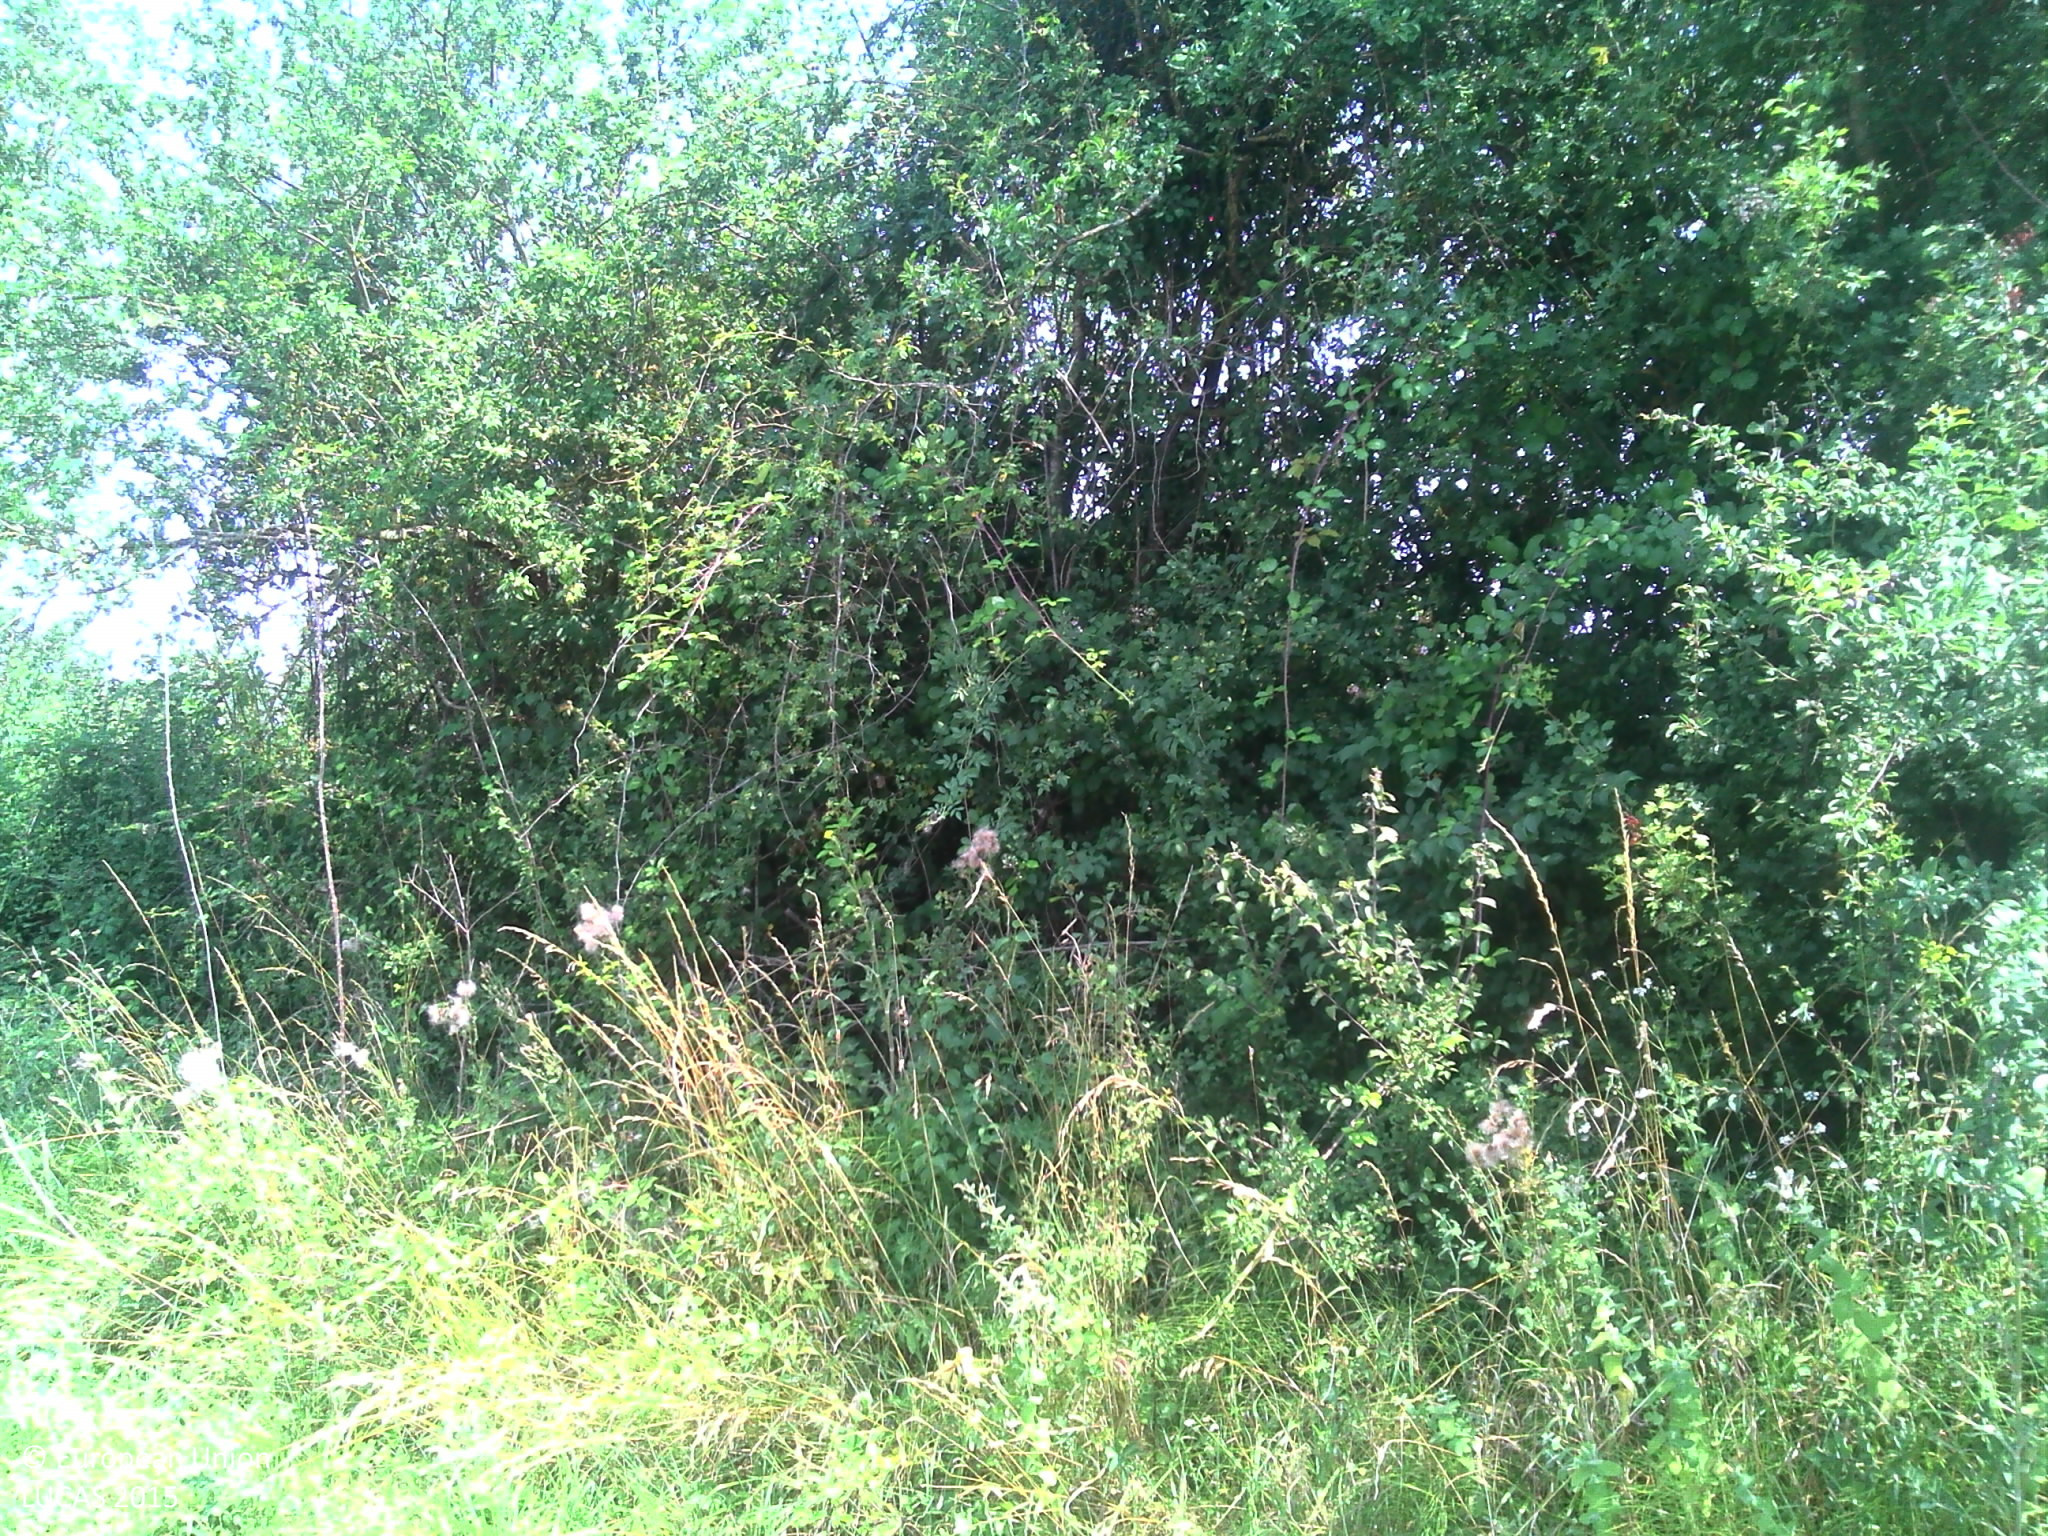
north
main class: Grassland
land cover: Grassland without tree/shrub cover
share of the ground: > 75 %
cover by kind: herbaceous plants 100 %
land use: Agriculture (excluding fallow land and kitchen gardens)
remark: Harvested field
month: July
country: FR
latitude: 43.3471
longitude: 1.0583
